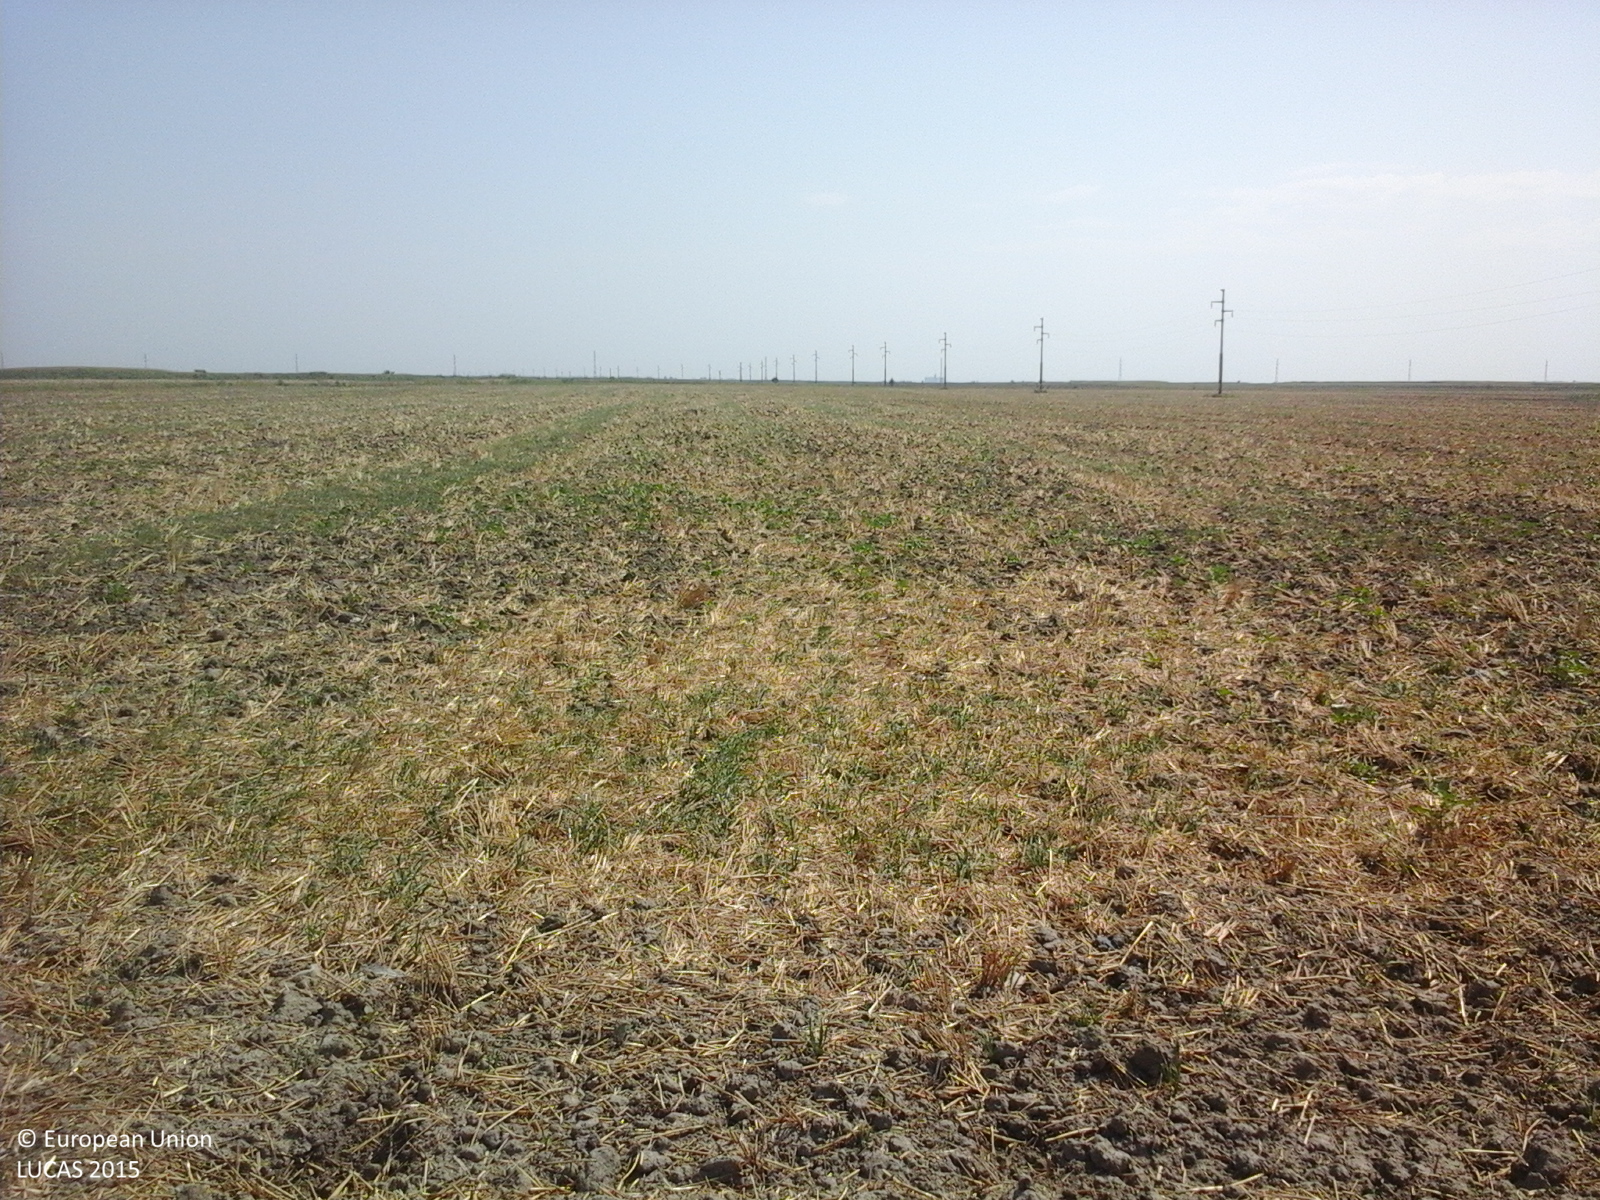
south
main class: Cropland
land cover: Common wheat
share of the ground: < 10 %
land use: Agriculture (excluding fallow land and kitchen gardens)
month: August
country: RO
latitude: 45.2772
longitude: 27.7372
